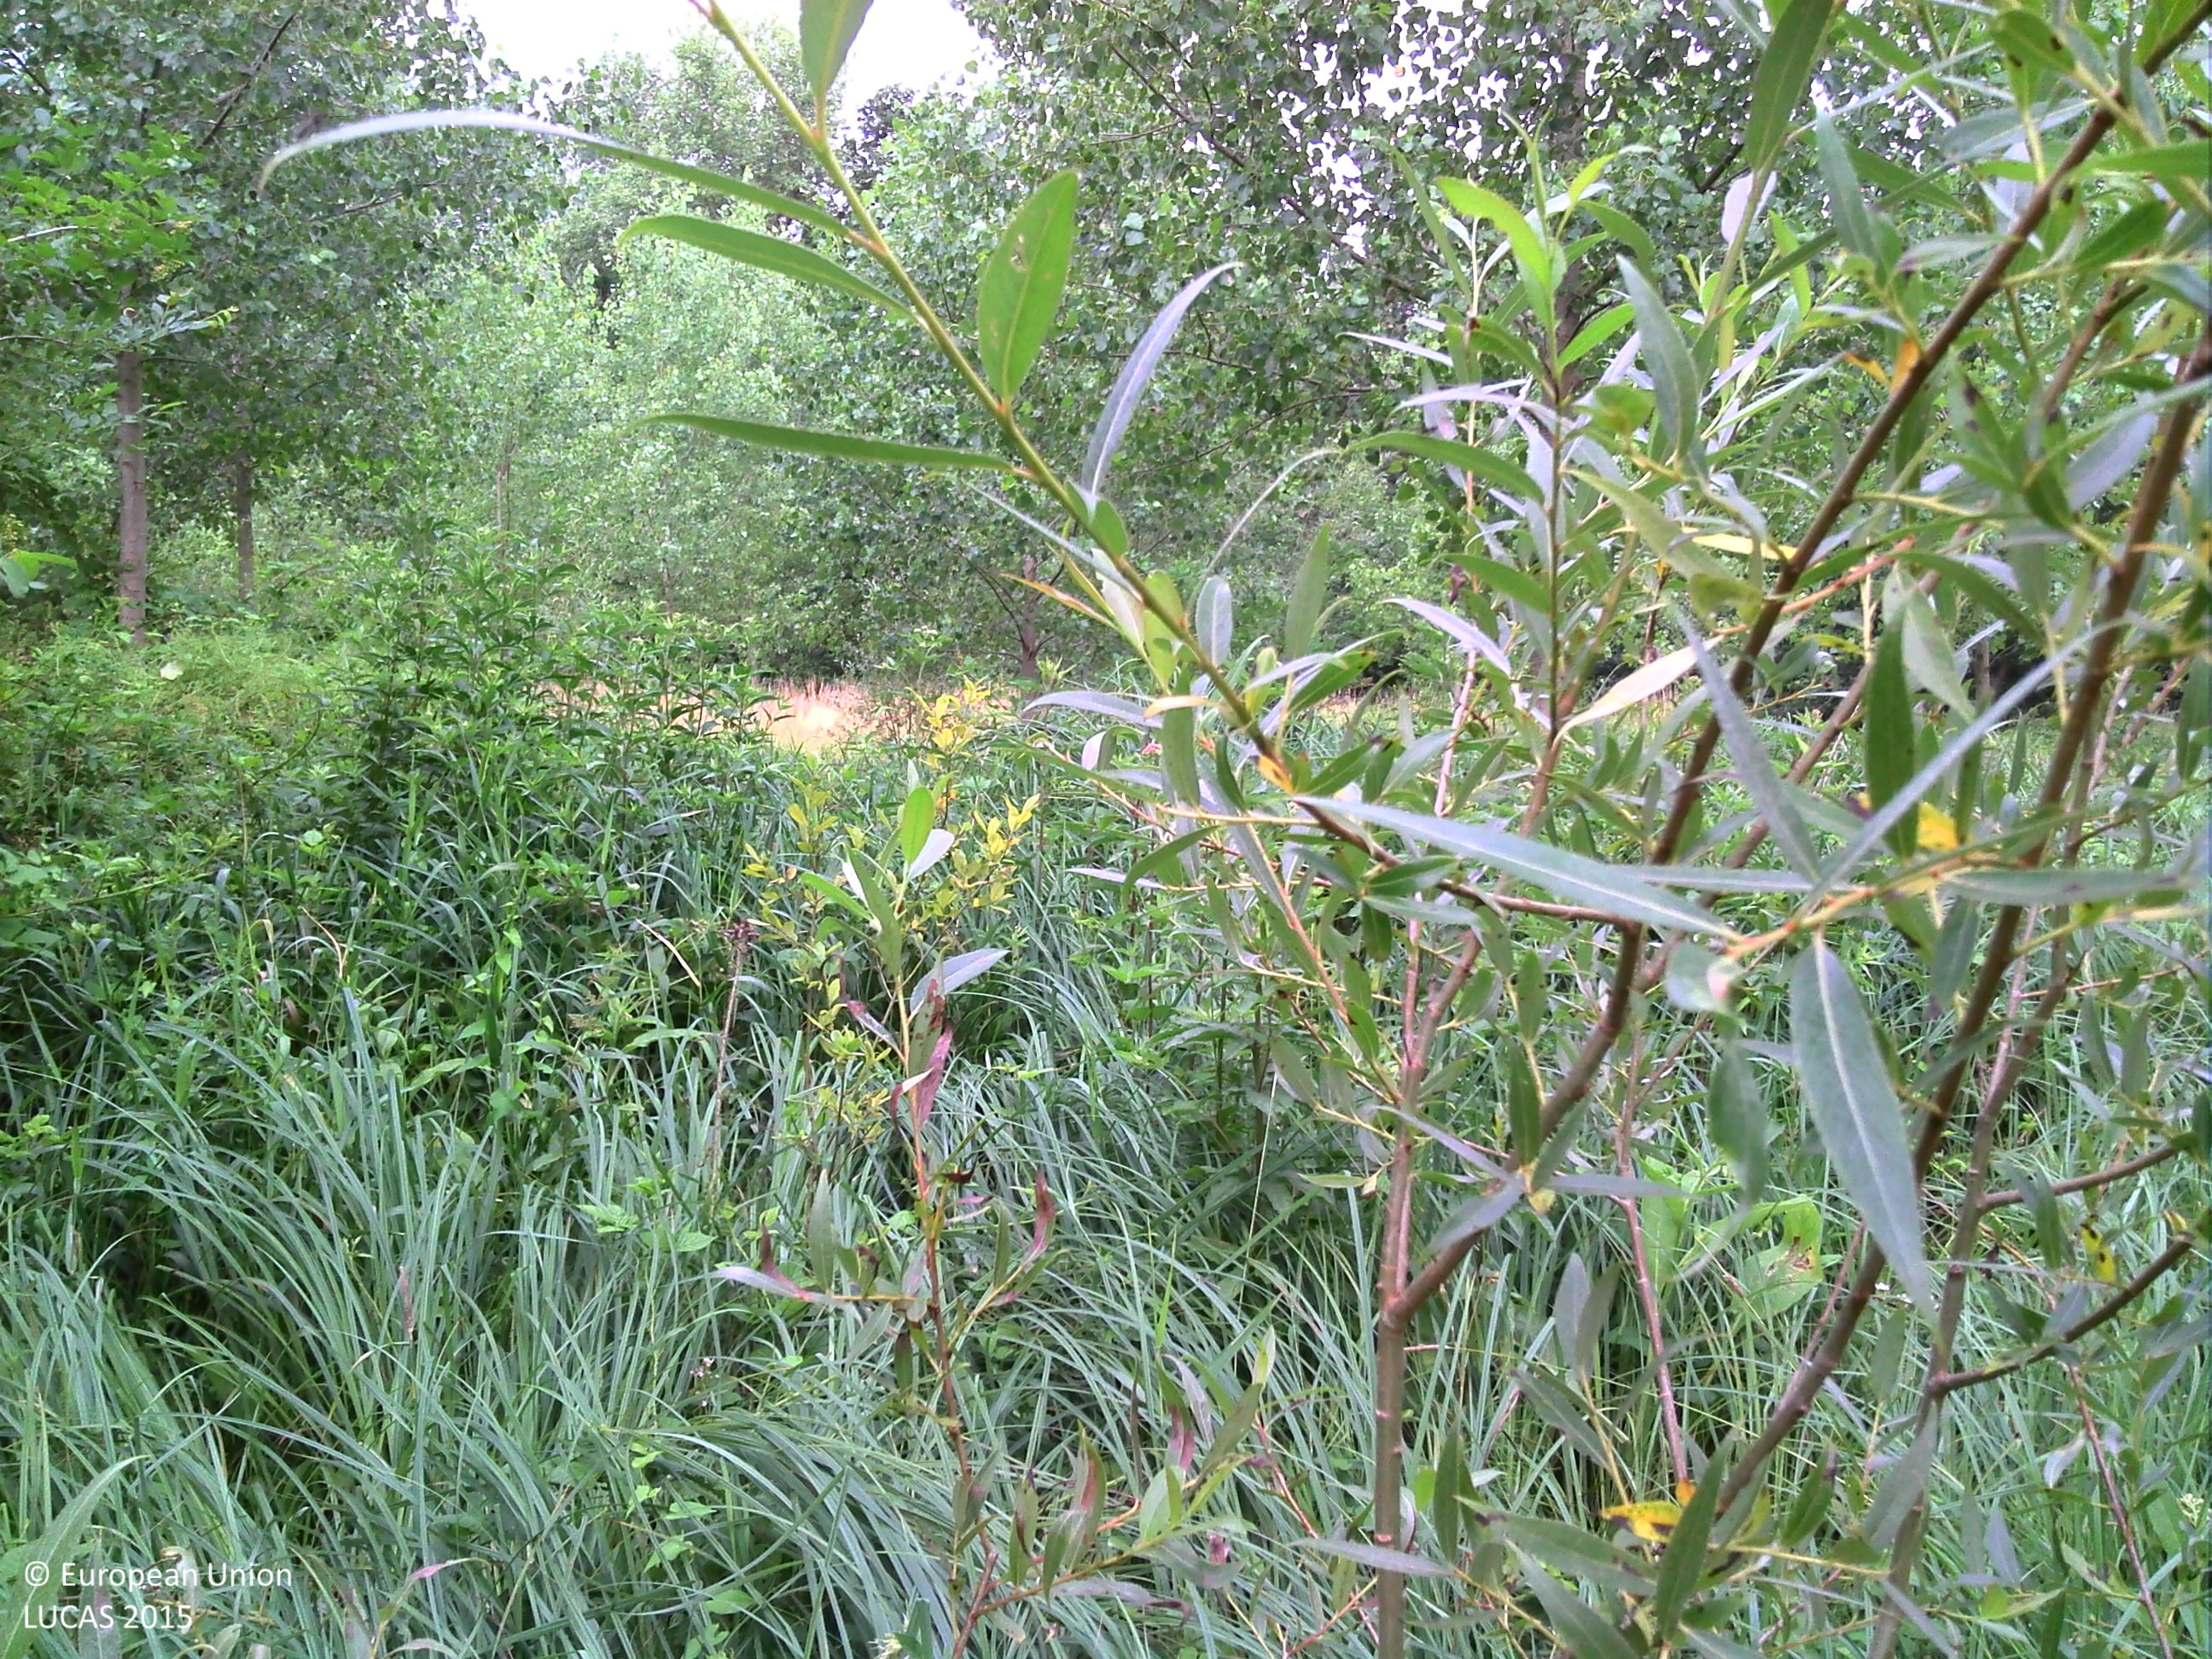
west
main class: Woodland
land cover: Broadleaved woodland
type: floodplain forest
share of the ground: 50 - 75 %
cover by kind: broadleaved forest trees 50 %, herbaceous plants 50 %
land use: Forestry
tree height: > 5 m
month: July
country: BE
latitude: 51.2463
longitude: 5.4568
